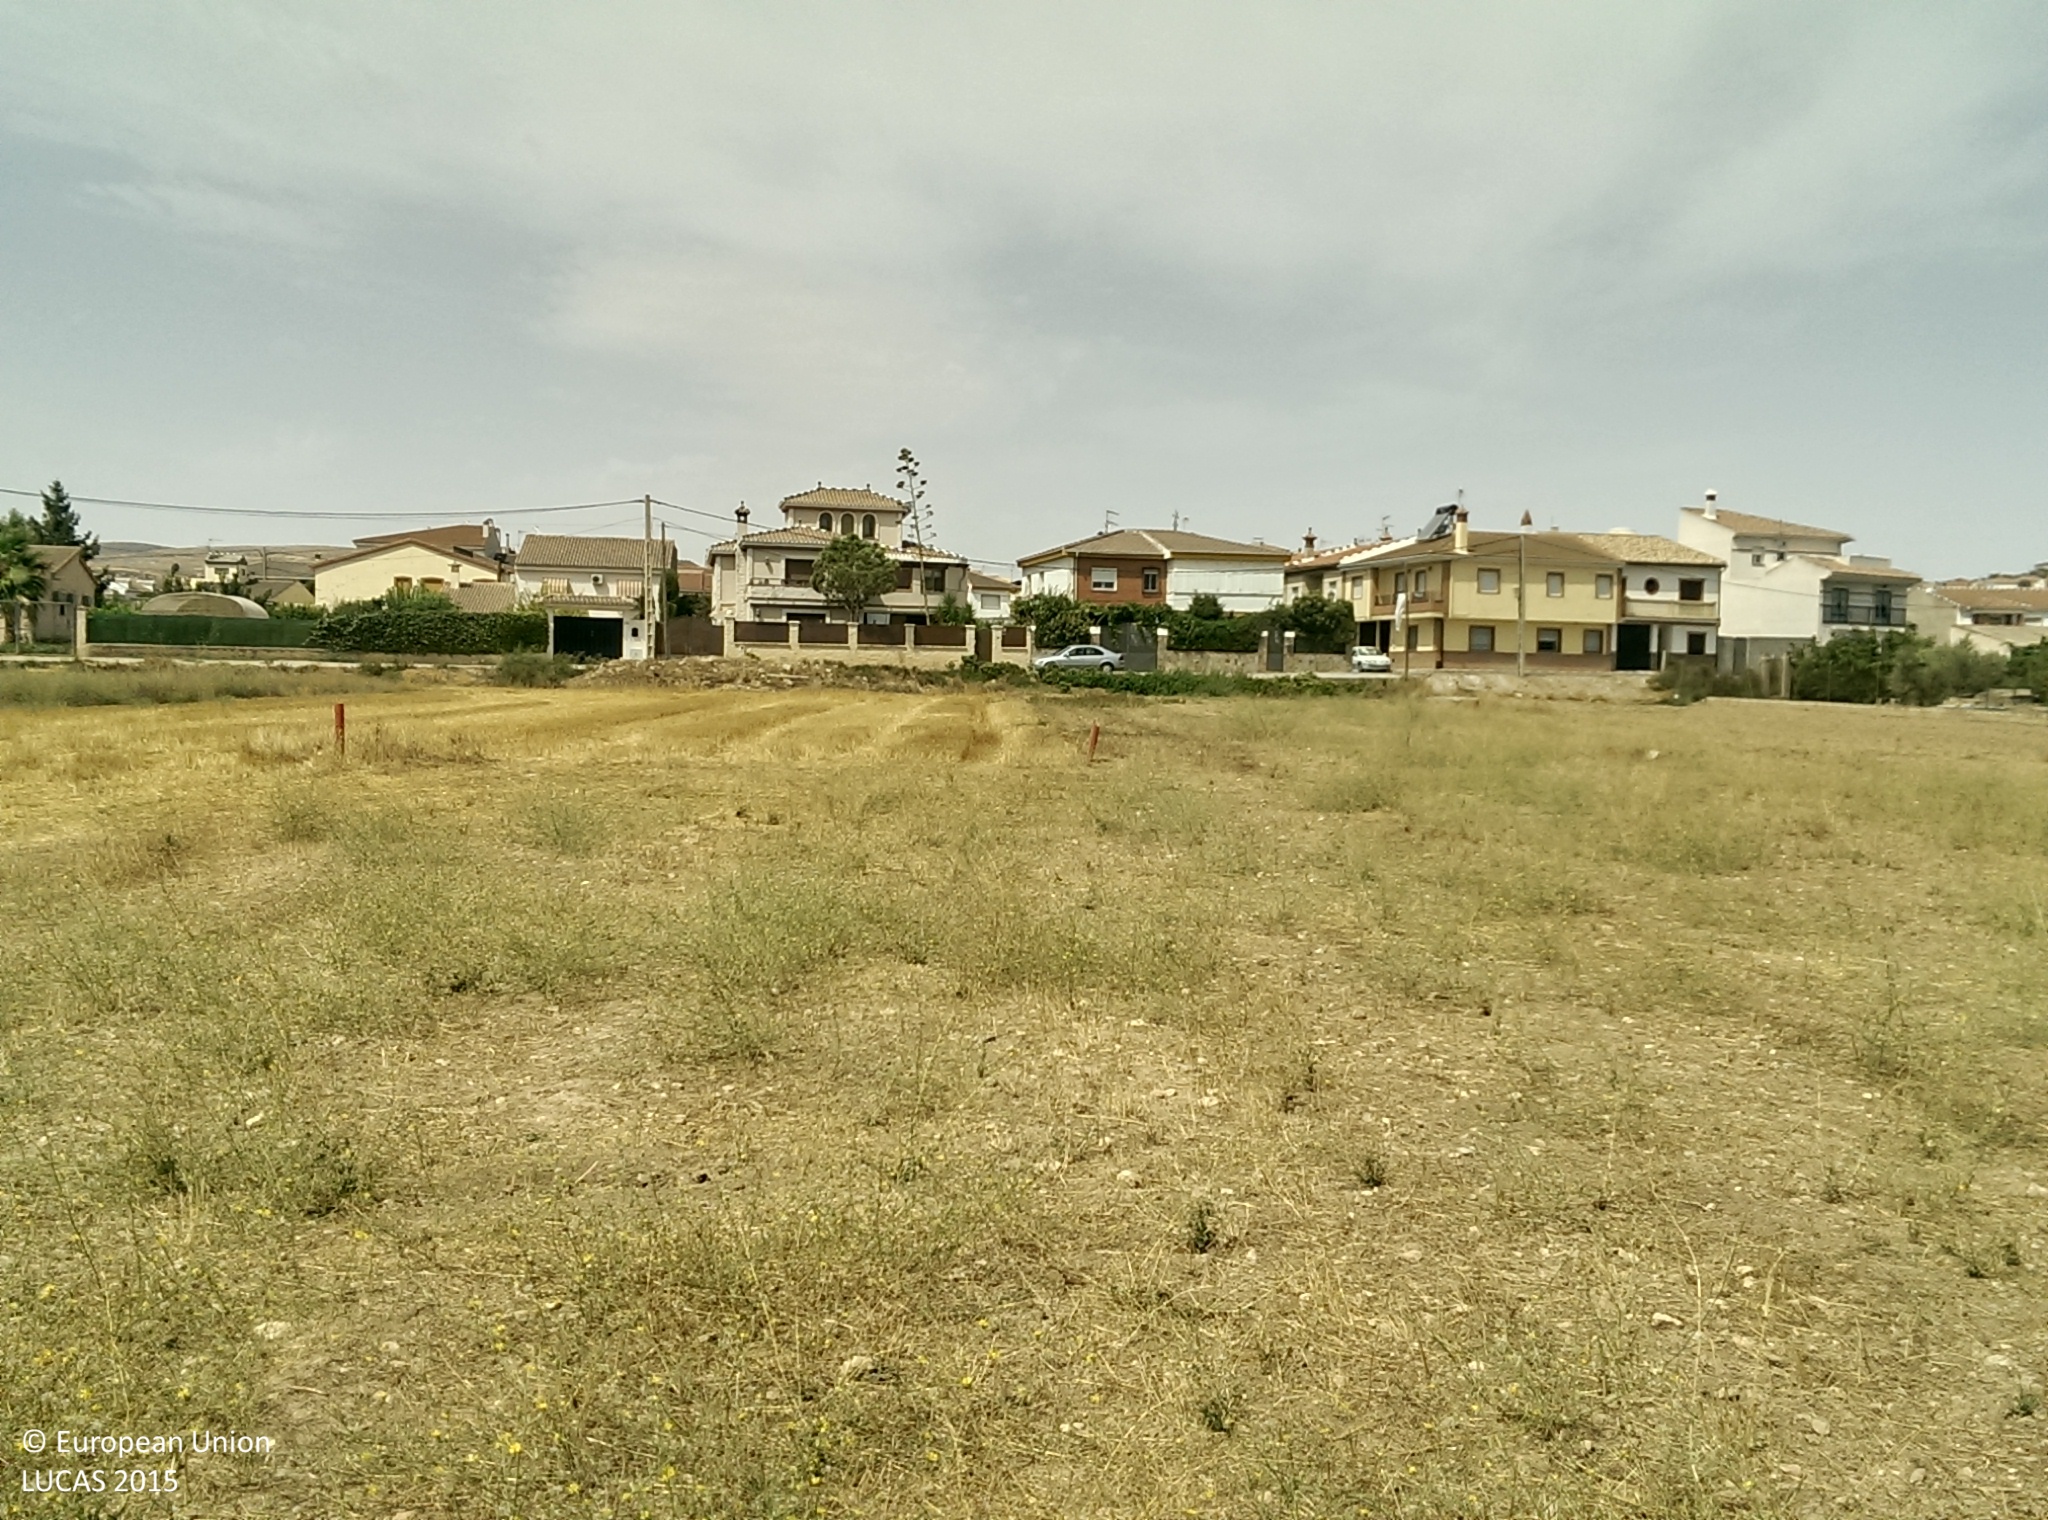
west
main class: Grassland
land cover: Spontaneously vegetated surfaces
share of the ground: 25 - 50 %
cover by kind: unconsolidated bare surface 70 %, herbaceous plants 30 %
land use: Agriculture (excluding fallow land and kitchen gardens)
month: August
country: ES
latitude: 37.0196
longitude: -3.6209
